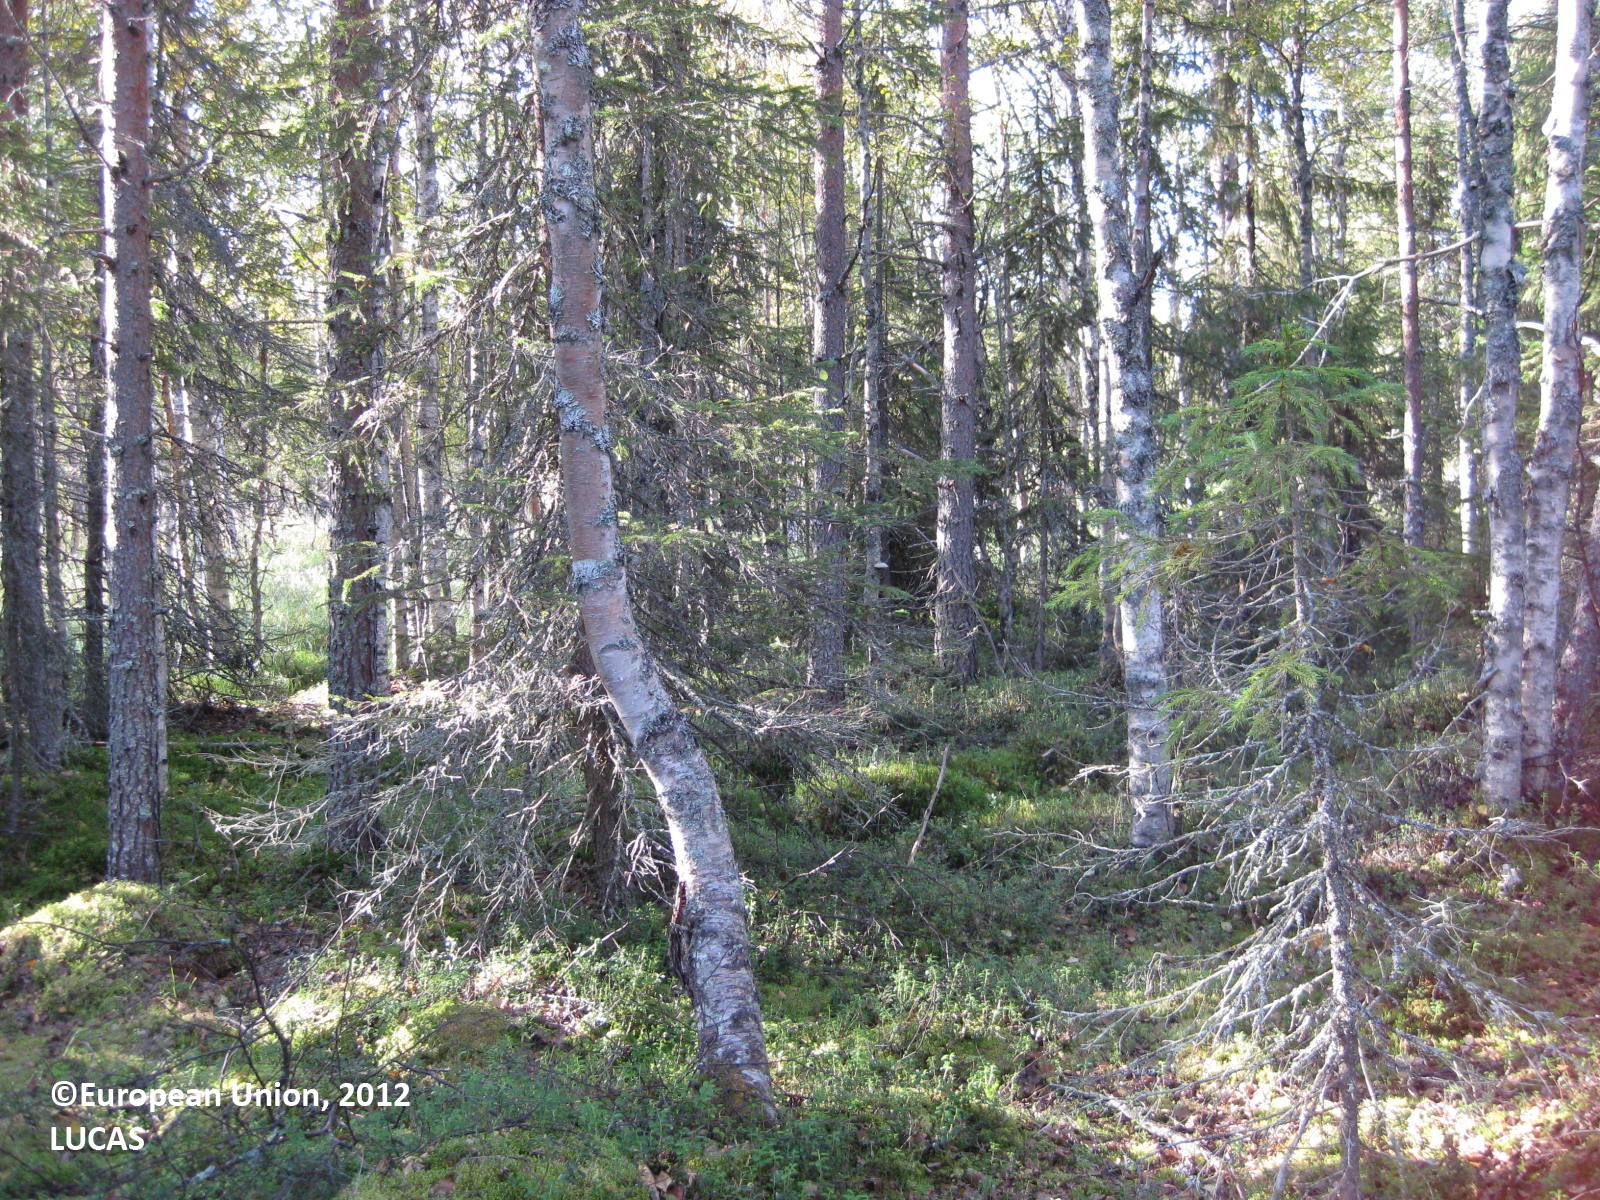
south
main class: Woodland
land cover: Other mixed woodland
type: boreal forest
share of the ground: > 75 %
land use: Forestry
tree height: > 5 m
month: August
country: FI
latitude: 66.0520
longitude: 29.5542
